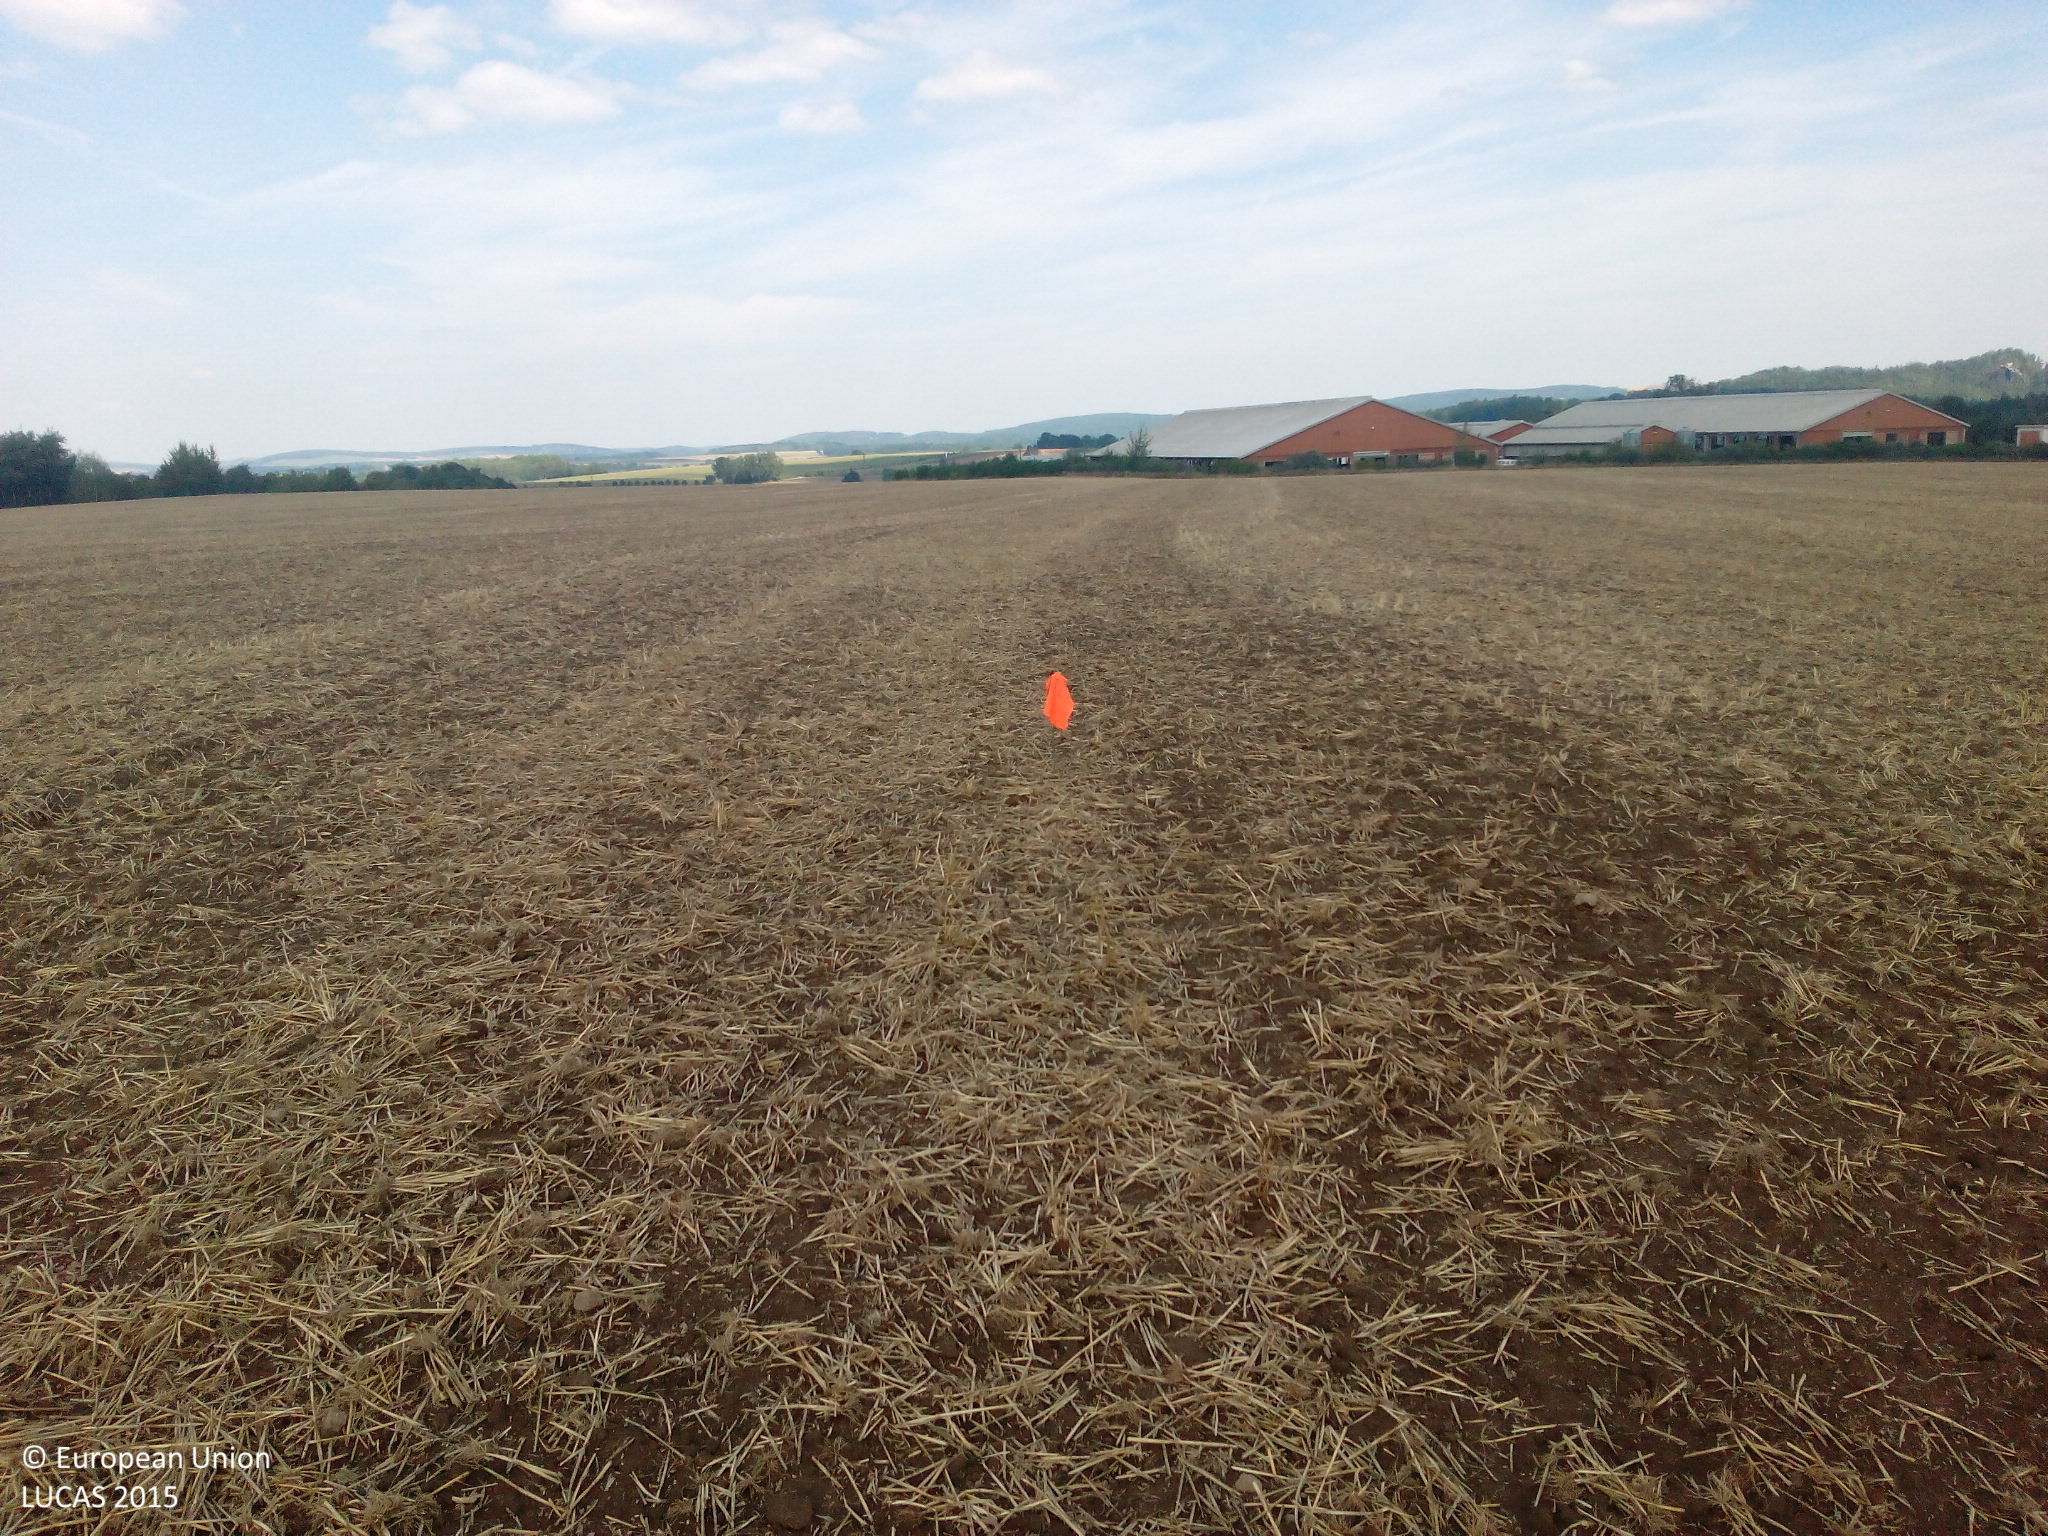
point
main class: Cropland
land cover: Common wheat
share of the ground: 10 - 25 %
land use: Agriculture (excluding fallow land and kitchen gardens)
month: August
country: DE
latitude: 50.9233
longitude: 14.0271
